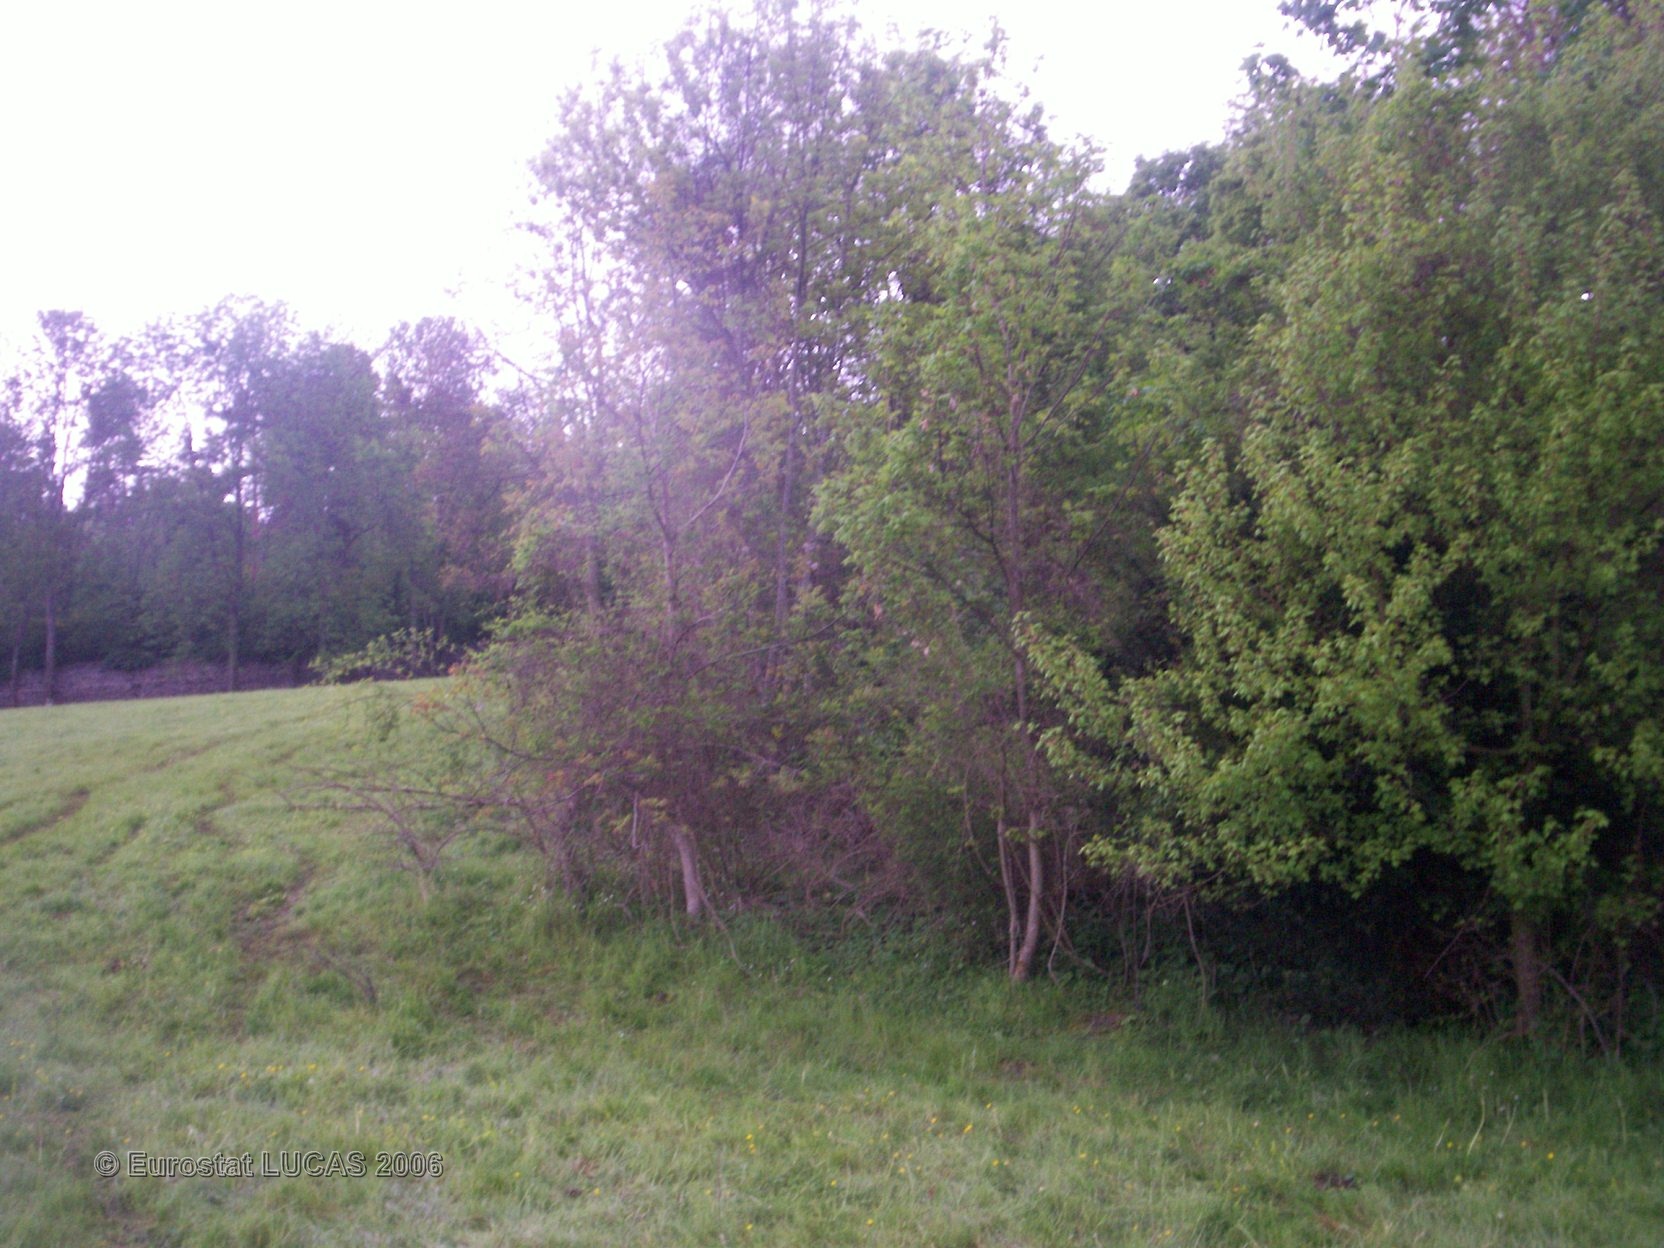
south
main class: Grassland
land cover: Grassland without tree/shrub cover
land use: Agriculture (excluding fallow land and kitchen gardens)
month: May
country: FR
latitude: 45.6588
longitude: 3.1084
